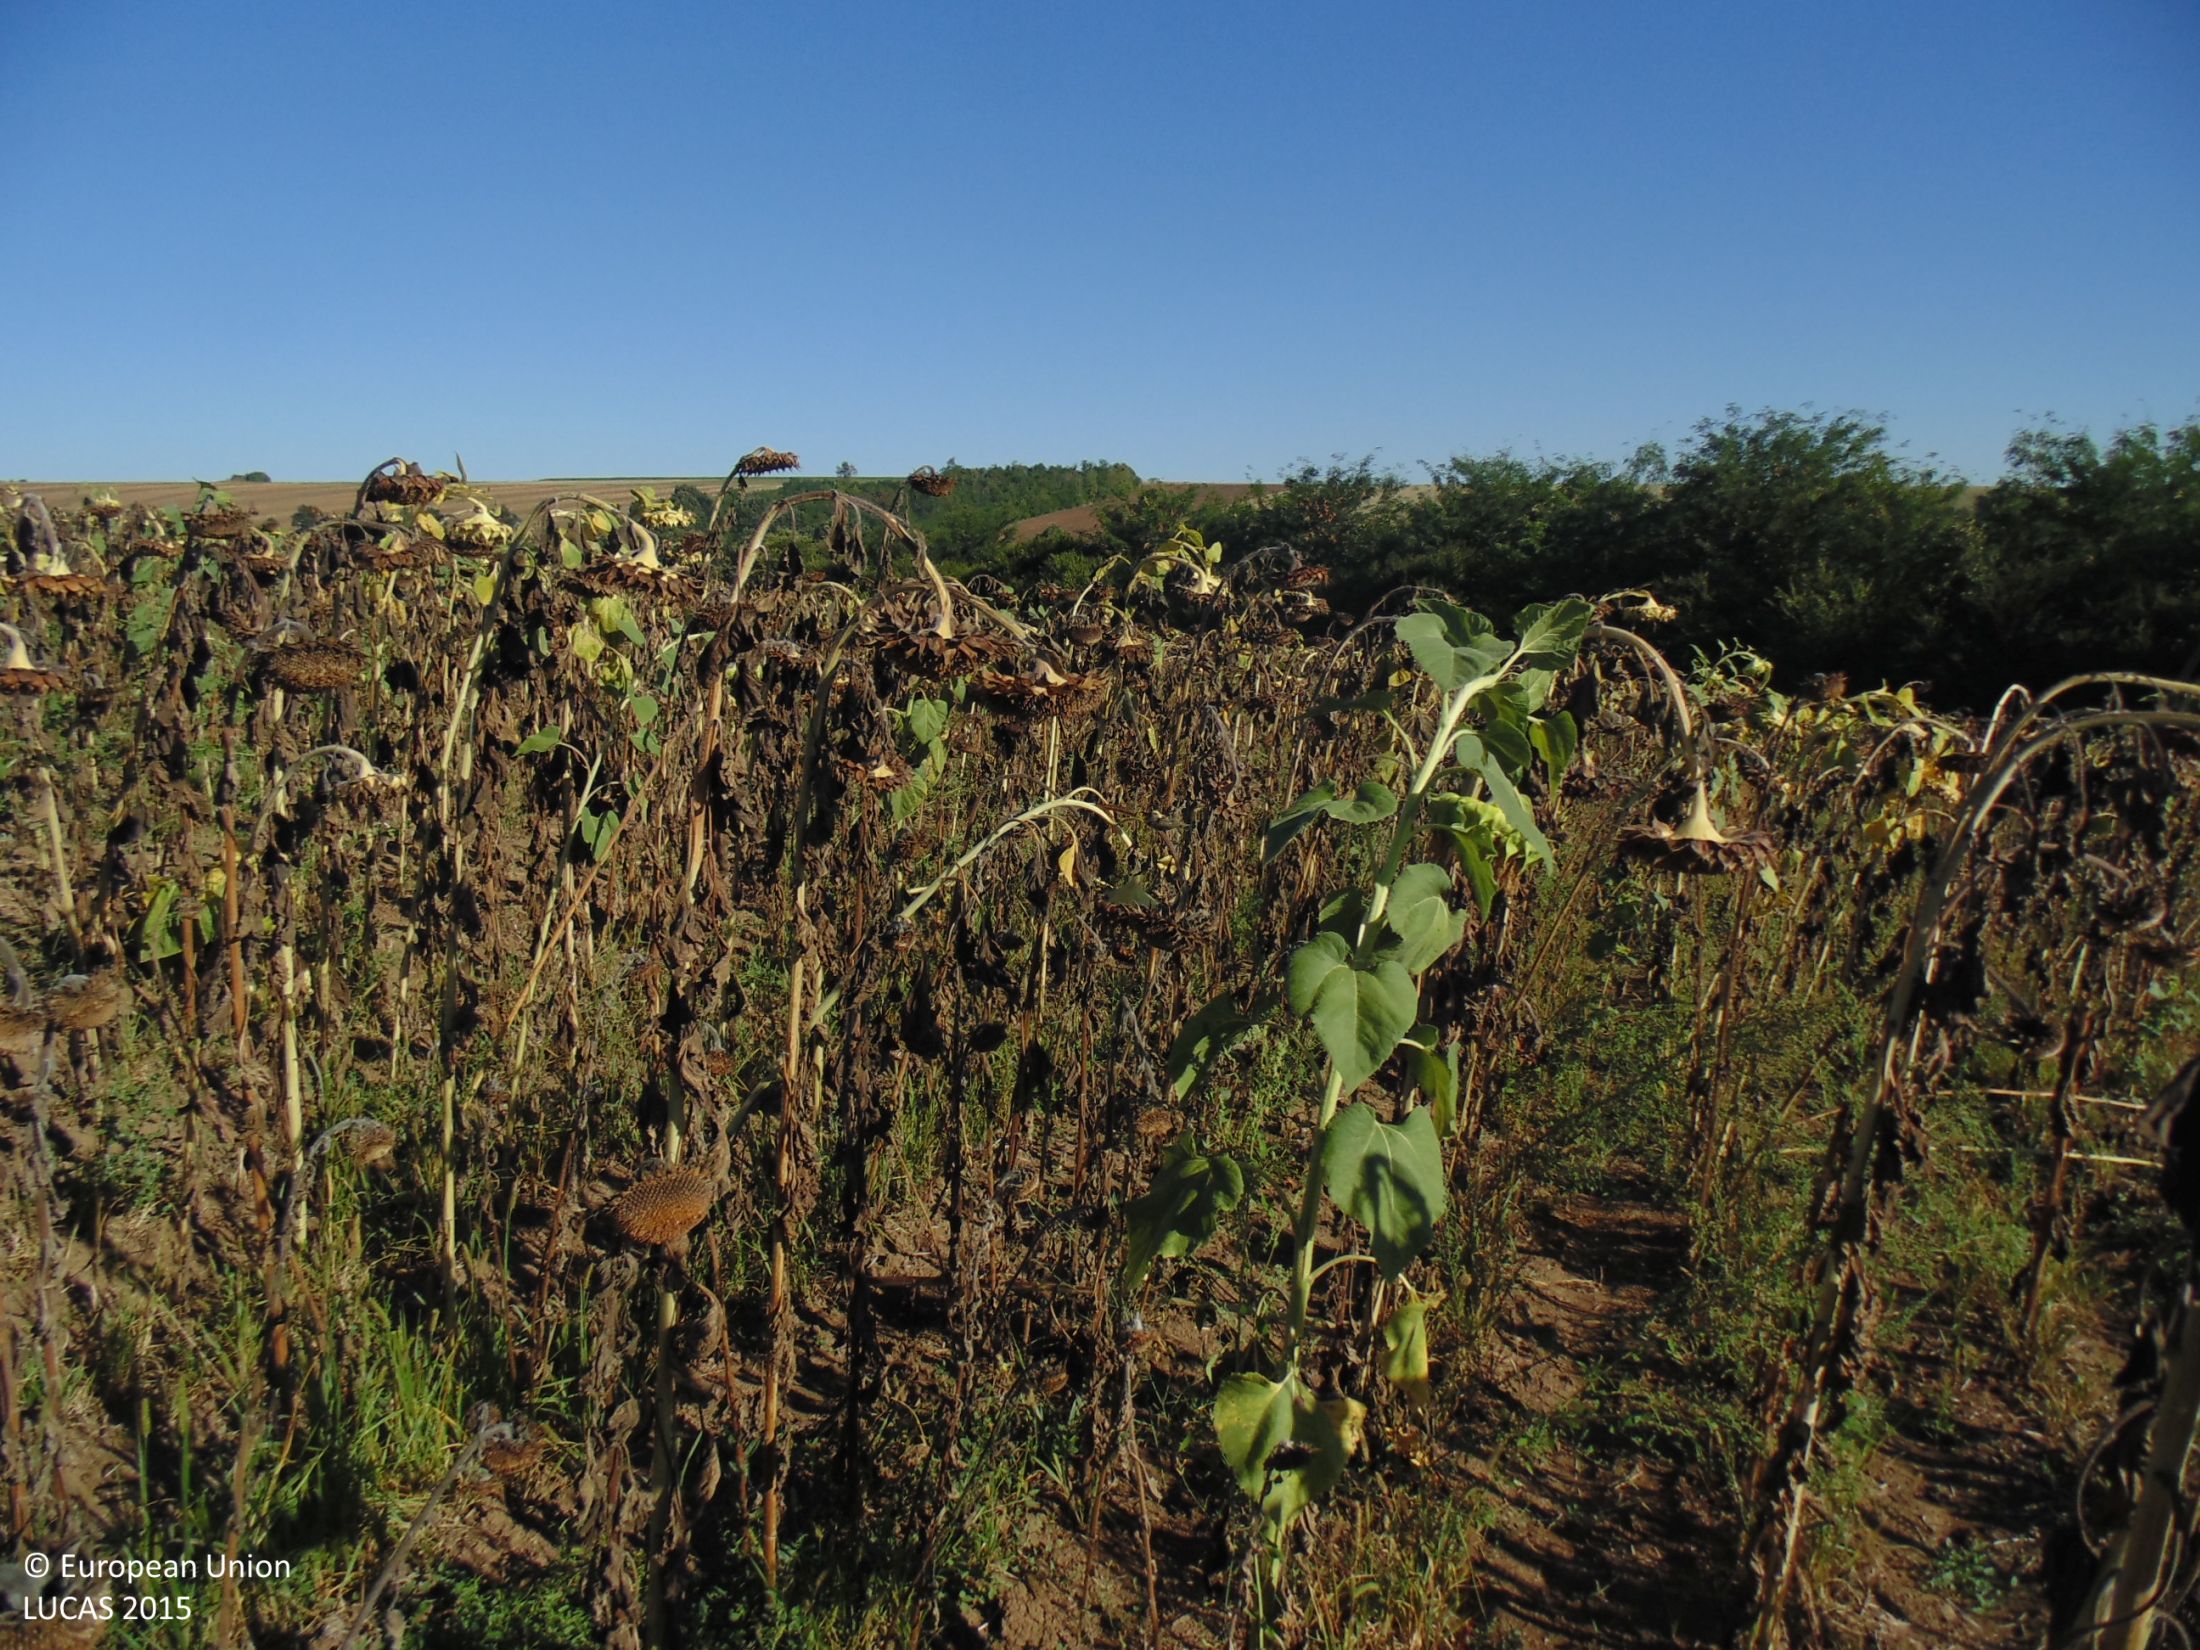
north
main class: Cropland
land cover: Sunflower
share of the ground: > 75 %
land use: Agriculture (excluding fallow land and kitchen gardens)
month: September
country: BG
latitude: 43.7612
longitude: 27.2307
